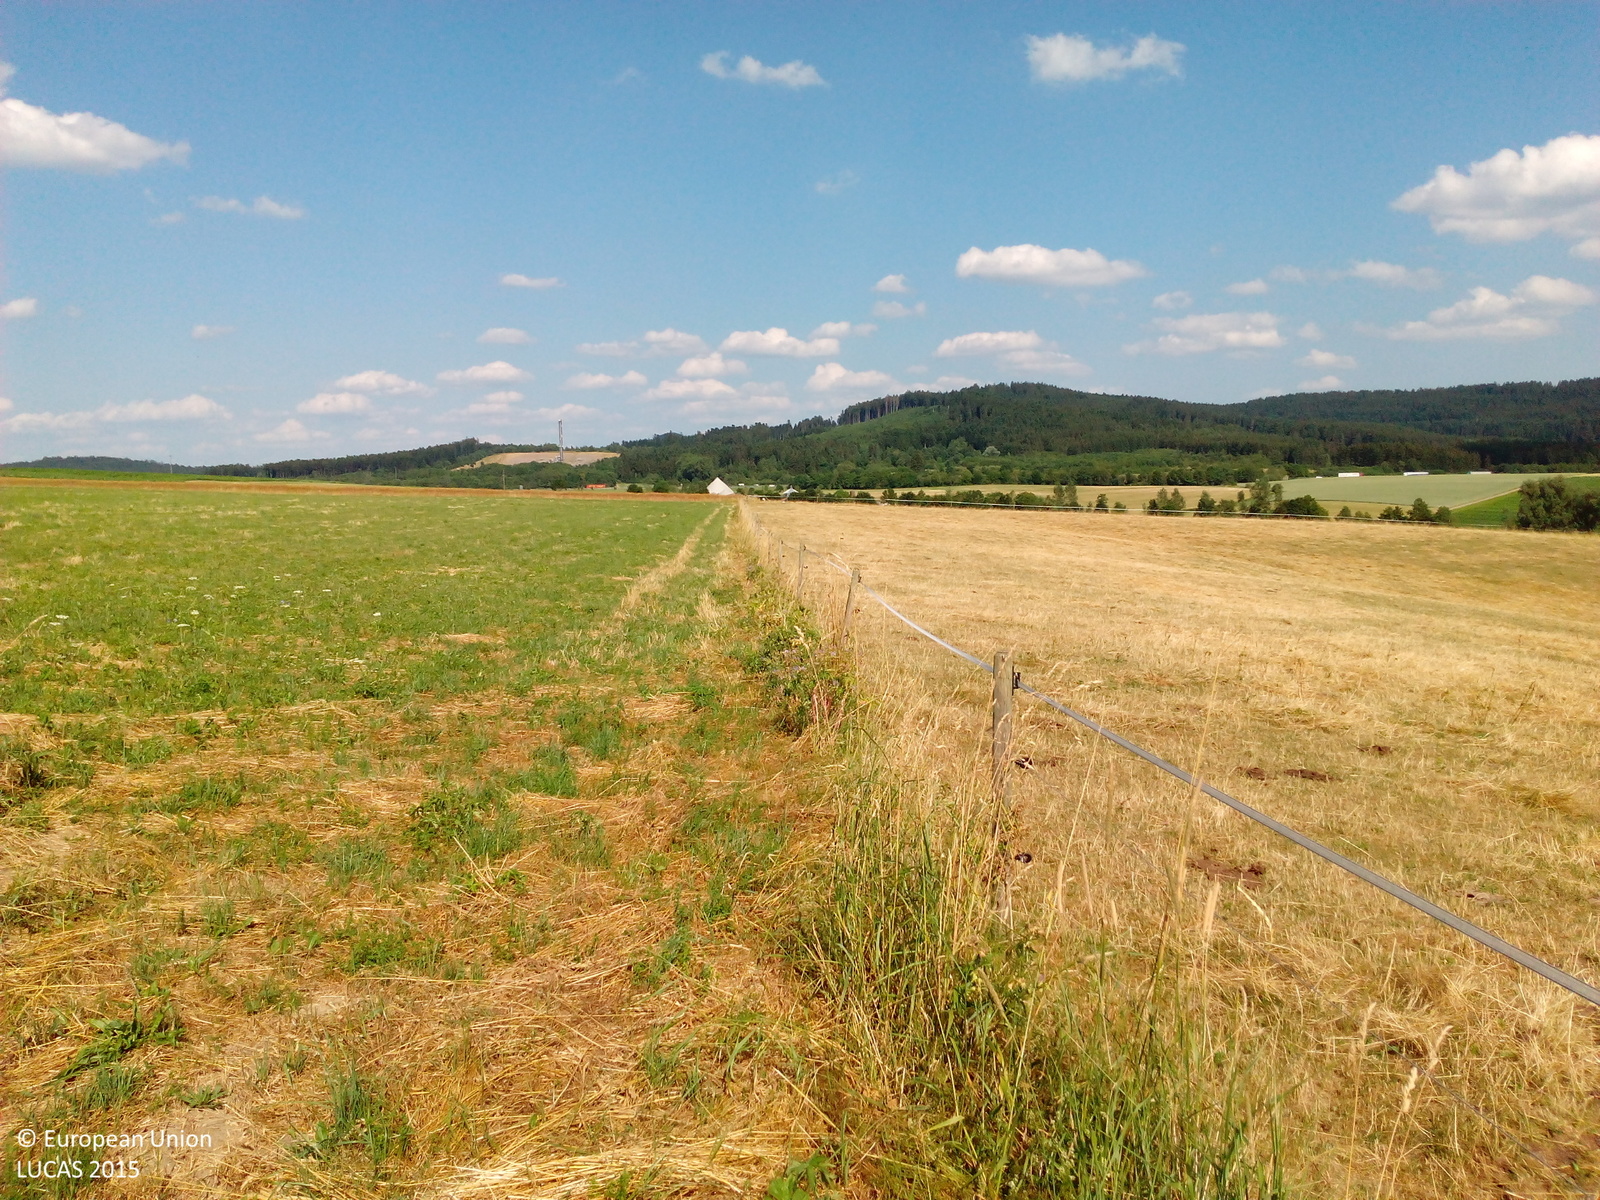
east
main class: Grassland
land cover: Grassland without tree/shrub cover
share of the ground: > 75 %
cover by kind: herbaceous plants 100 %
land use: Agriculture (excluding fallow land and kitchen gardens)
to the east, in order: Grassland without tree/shrub cover; Fences; Grassland without tree/shrub cover; Fences; Grassland without tree/shrub cover
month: July
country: DE
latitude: 48.0166
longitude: 8.5932
